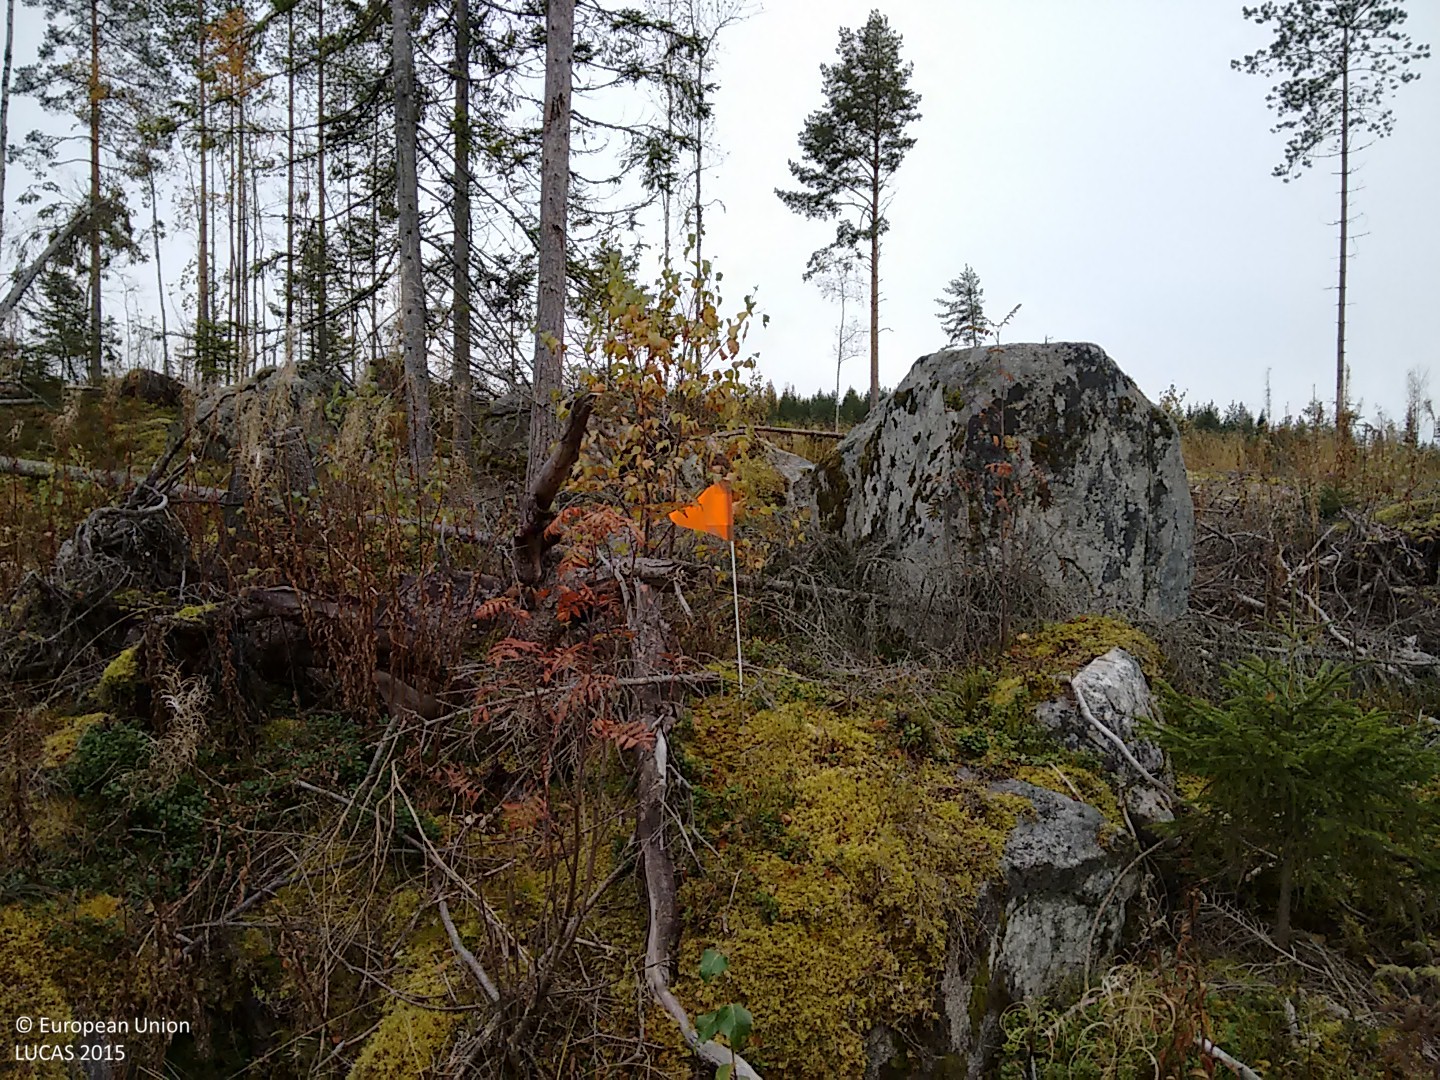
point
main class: Woodland
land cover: Other mixed woodland
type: boreal forest
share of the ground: 50 - 75 %
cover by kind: coniferous forest trees 35 %, broadleaved forest trees 35 %, herbaceous plants 15 %, shrubs 10 %, unconsolidated bare surface 5 %
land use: Forestry
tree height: < 5 m
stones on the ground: > 50 %
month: October
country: FI
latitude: 62.7051
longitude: 26.3754
